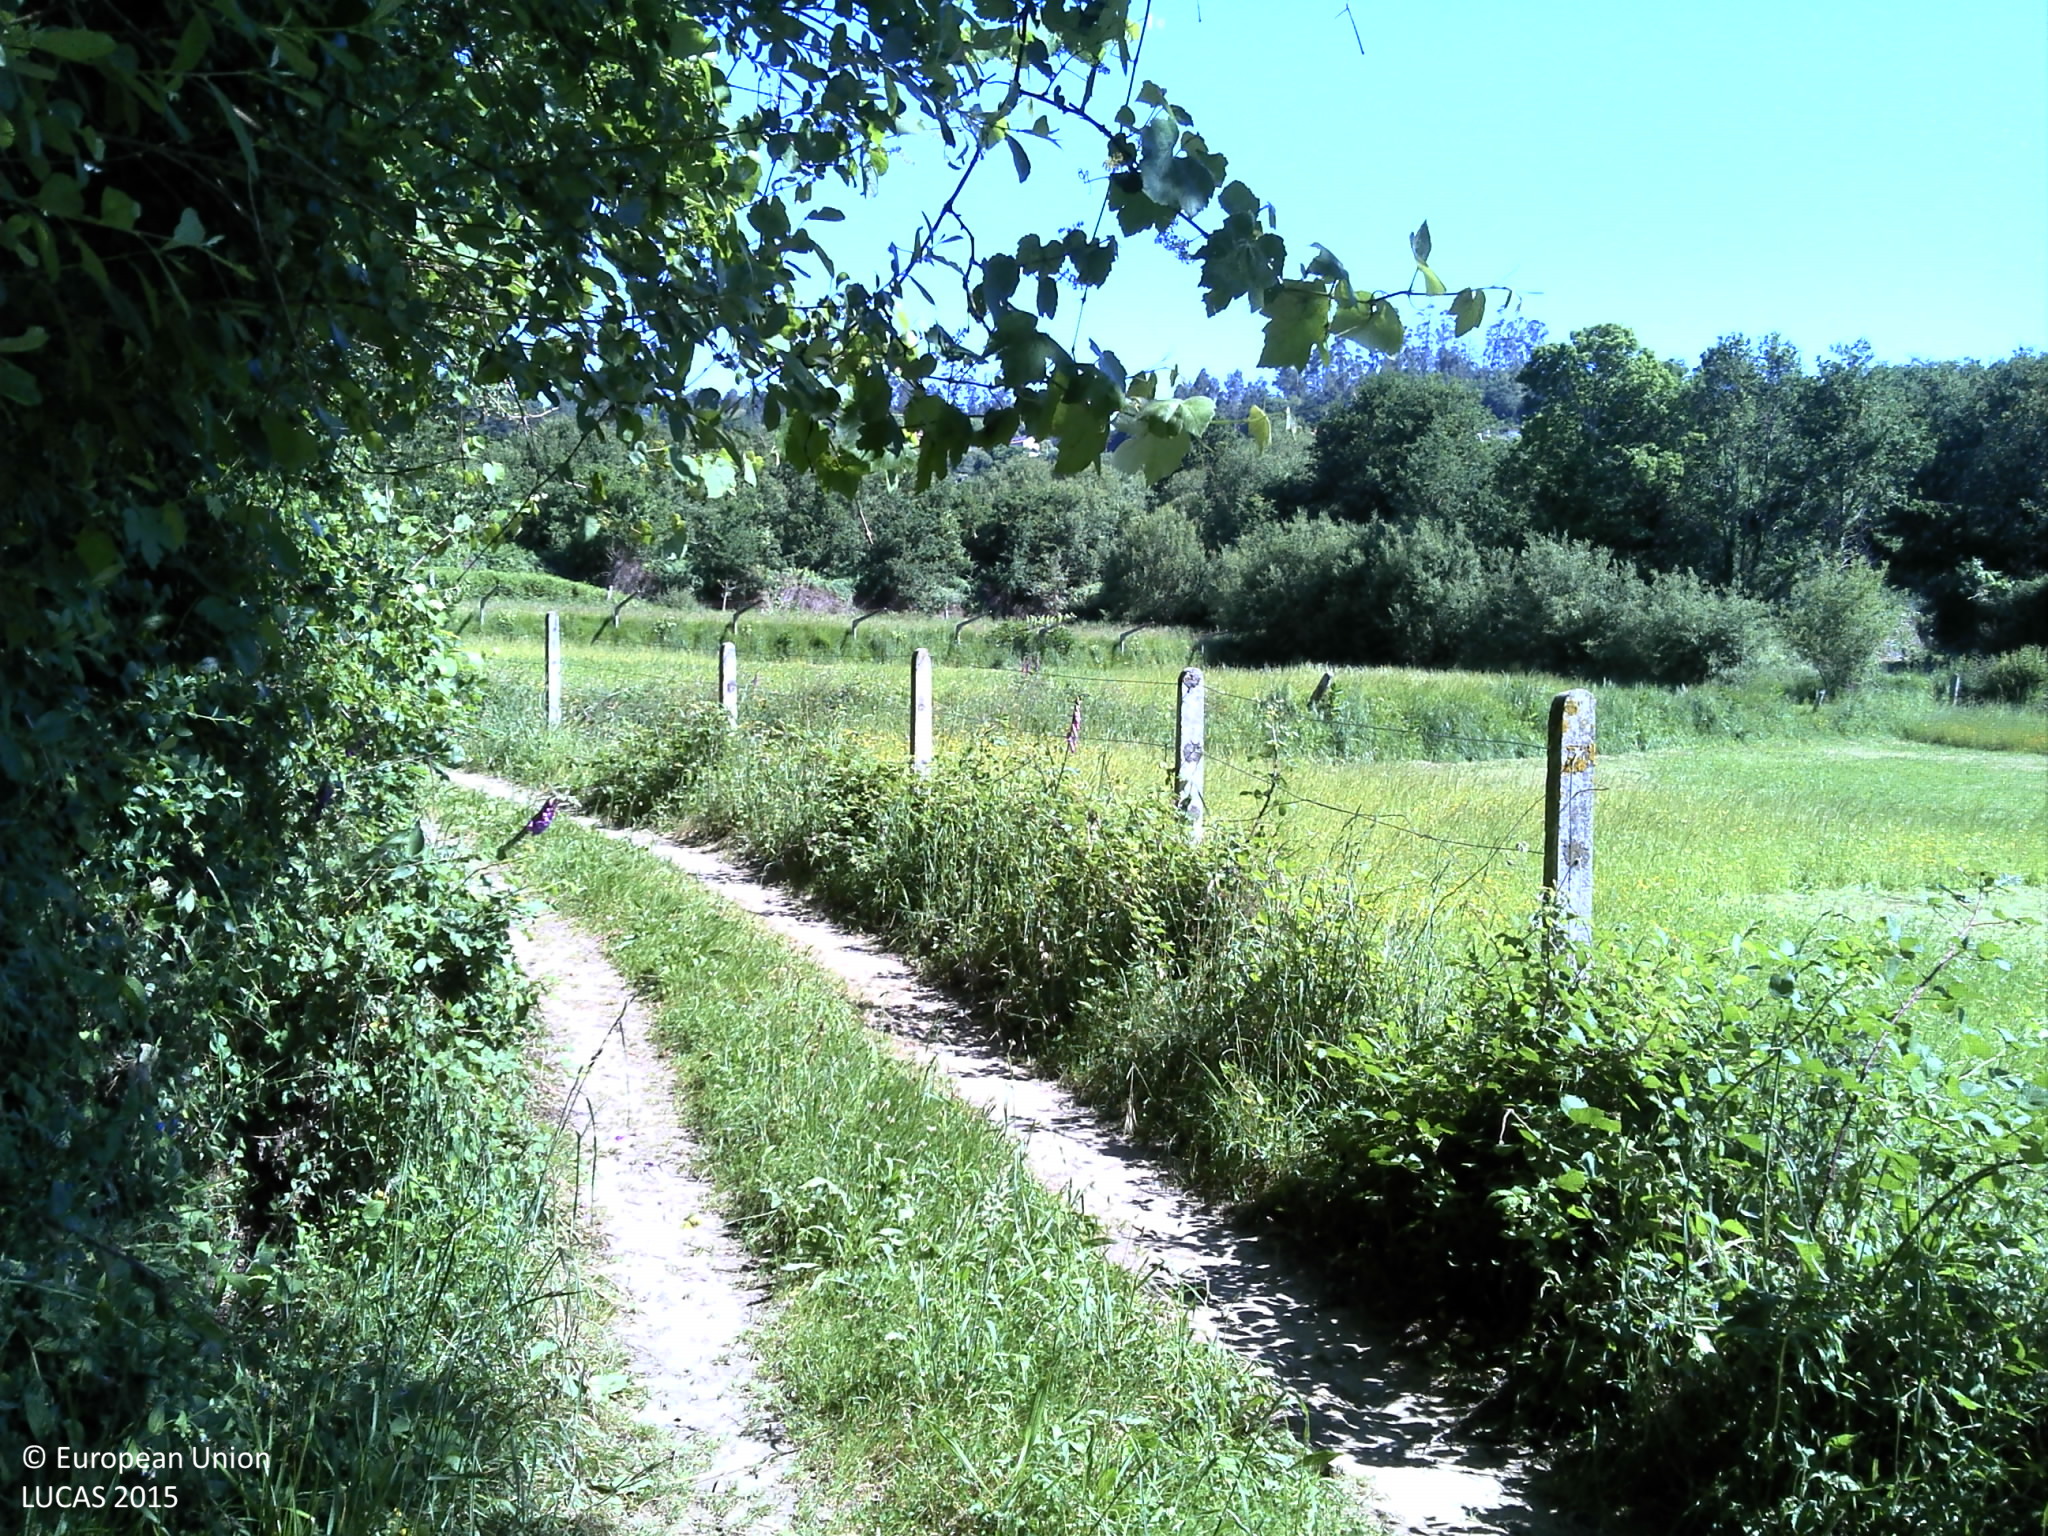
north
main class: Woodland
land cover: Broadleaved woodland
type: mesophytic deciduous forest
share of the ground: > 75 %
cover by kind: broadleaved forest trees 85 %, shrubs 5 %, herbaceous plants 5 %, unconsolidated bare surface 5 %
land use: Semi-natural and natural areas not in use
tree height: > 5 m
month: May
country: PT
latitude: 41.8982
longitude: -8.6692
